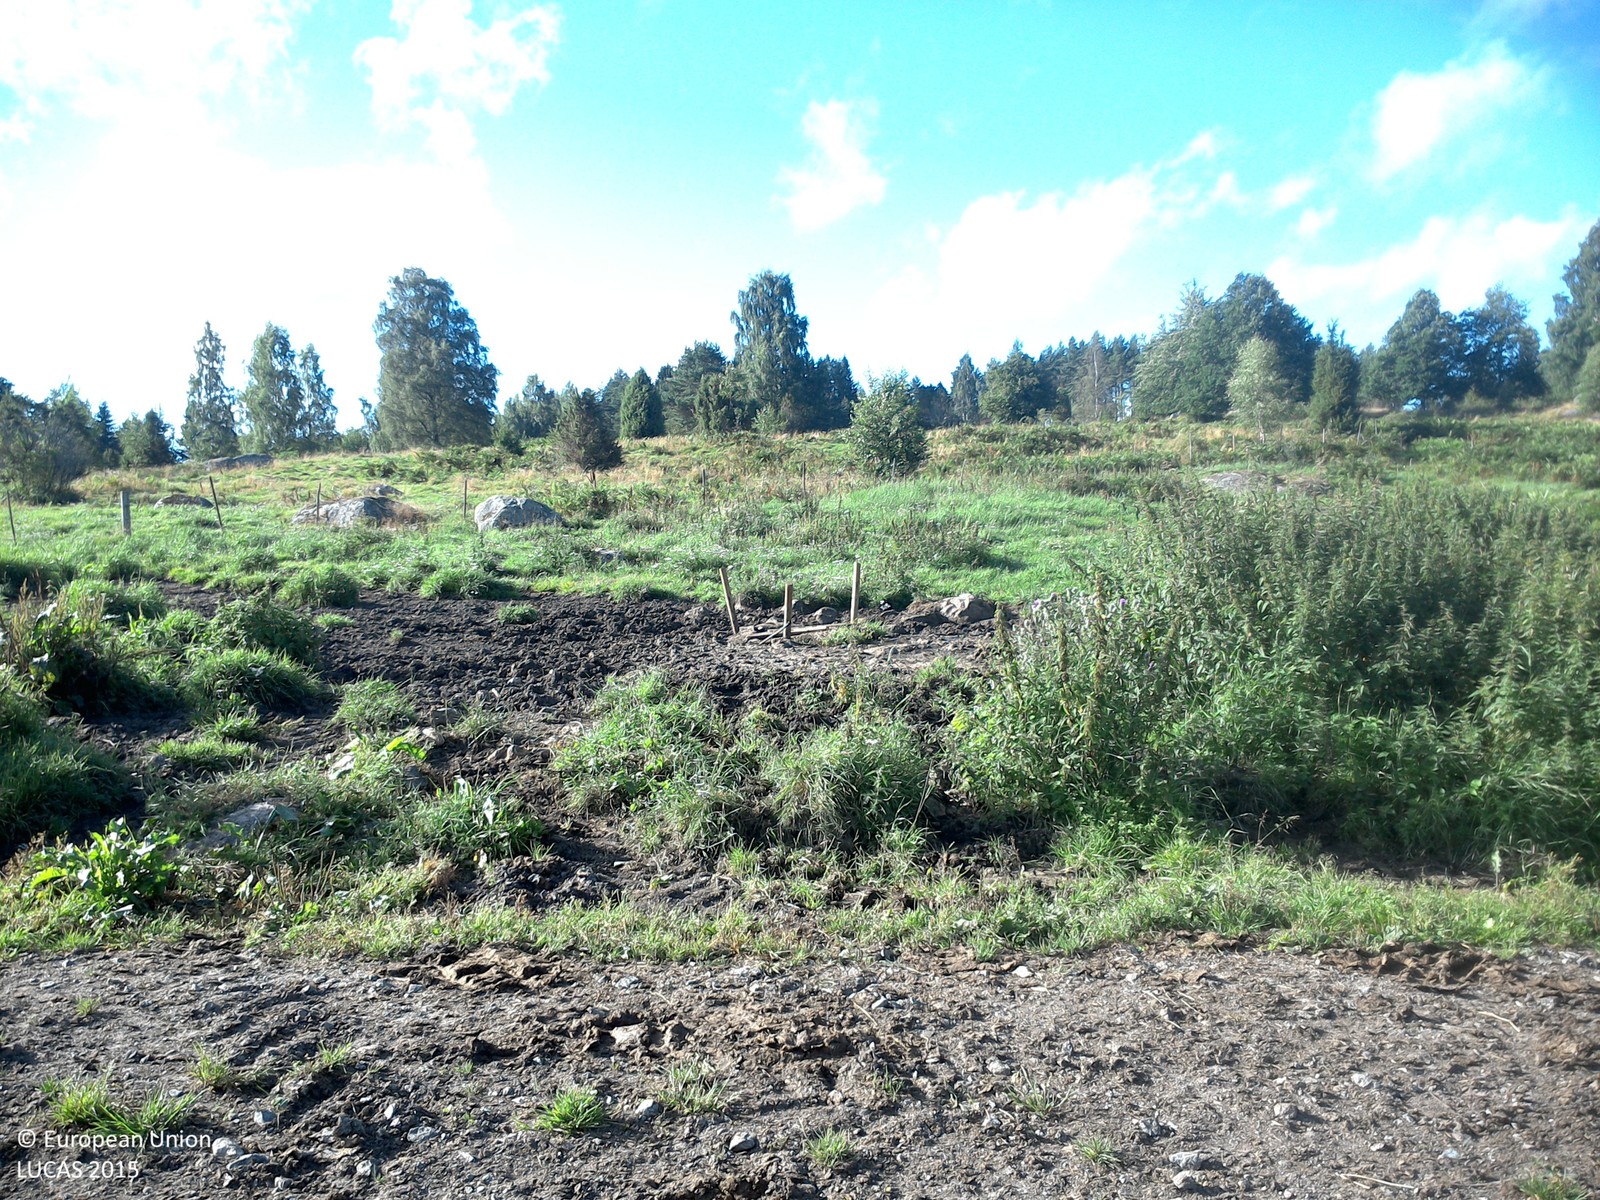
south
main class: Grassland
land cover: Grassland without tree/shrub cover
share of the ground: > 75 %
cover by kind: herbaceous plants 100 %
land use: Agriculture (excluding fallow land and kitchen gardens)
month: August
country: SE
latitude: 57.9176
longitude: 15.2790
